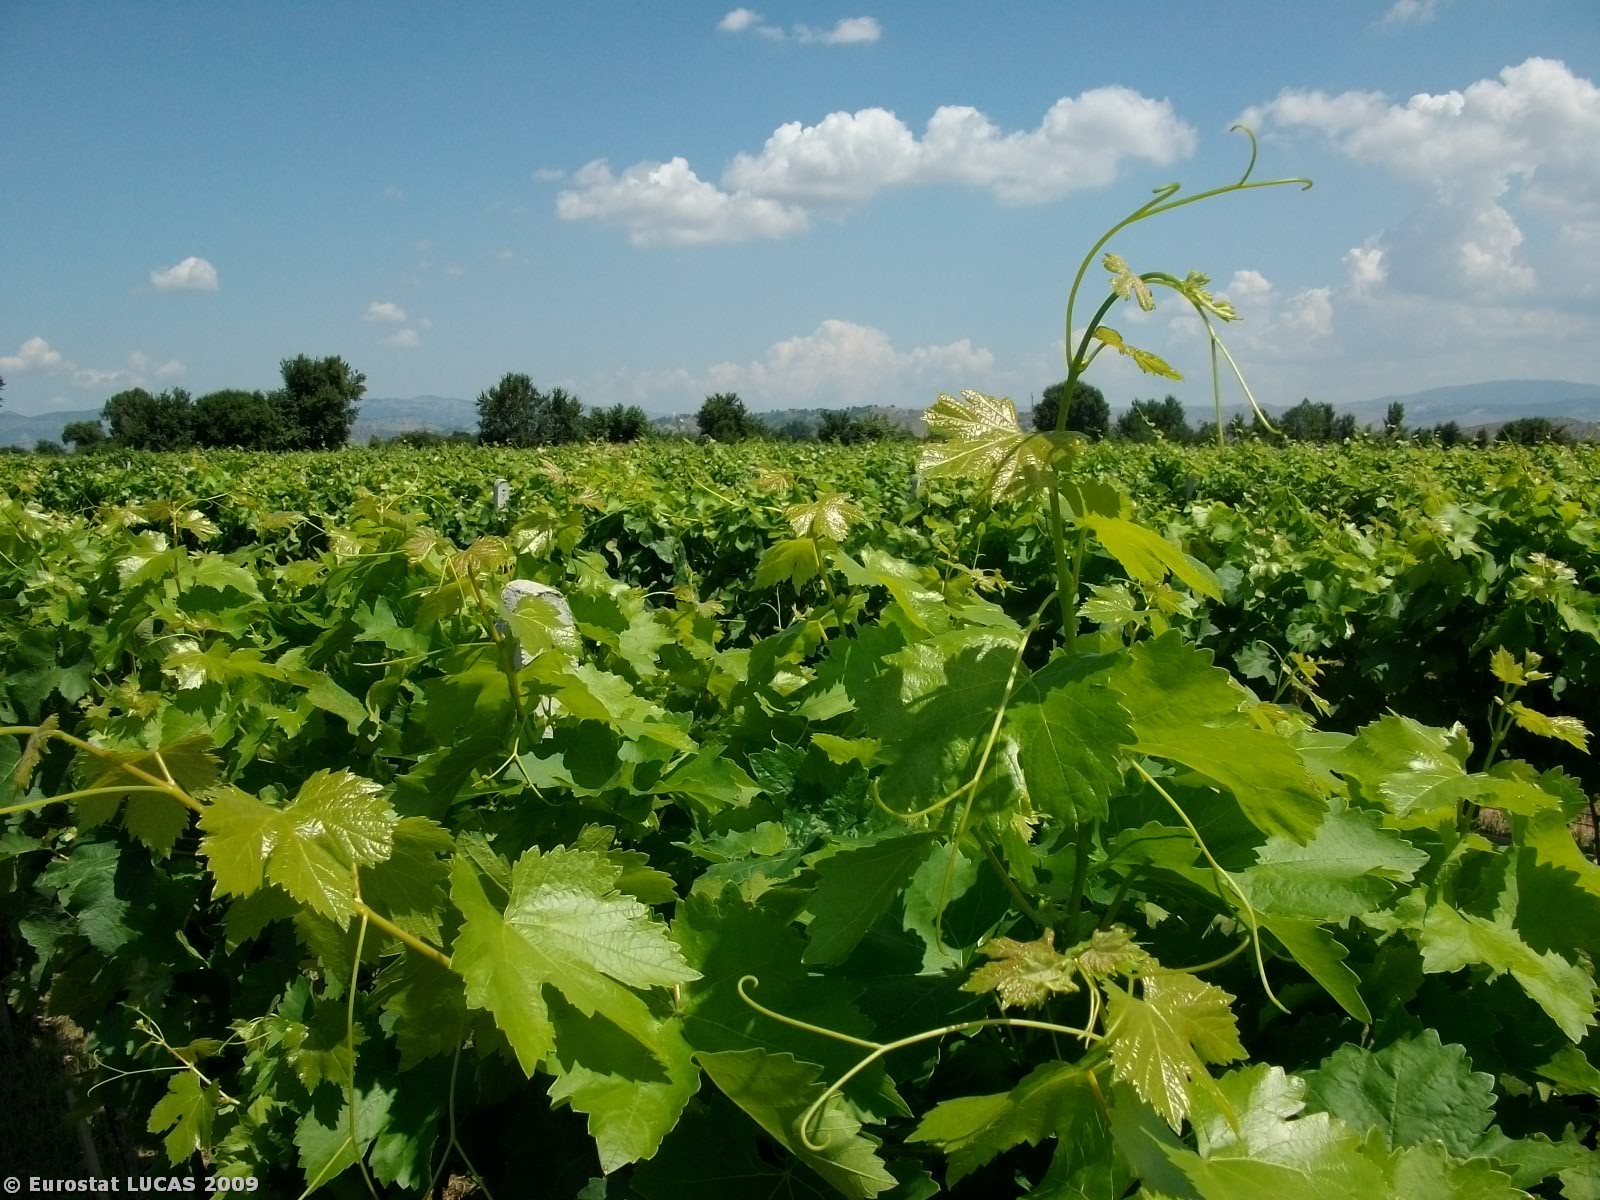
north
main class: Cropland
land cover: Vineyards
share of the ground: 25 - 50 %
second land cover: Grassland with sparse tree/shrub cover
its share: > 75 %
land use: Agriculture (excluding fallow land and kitchen gardens)
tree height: < 5 m
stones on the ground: < 10 %
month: July
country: GR
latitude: 39.6000
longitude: 21.7106
